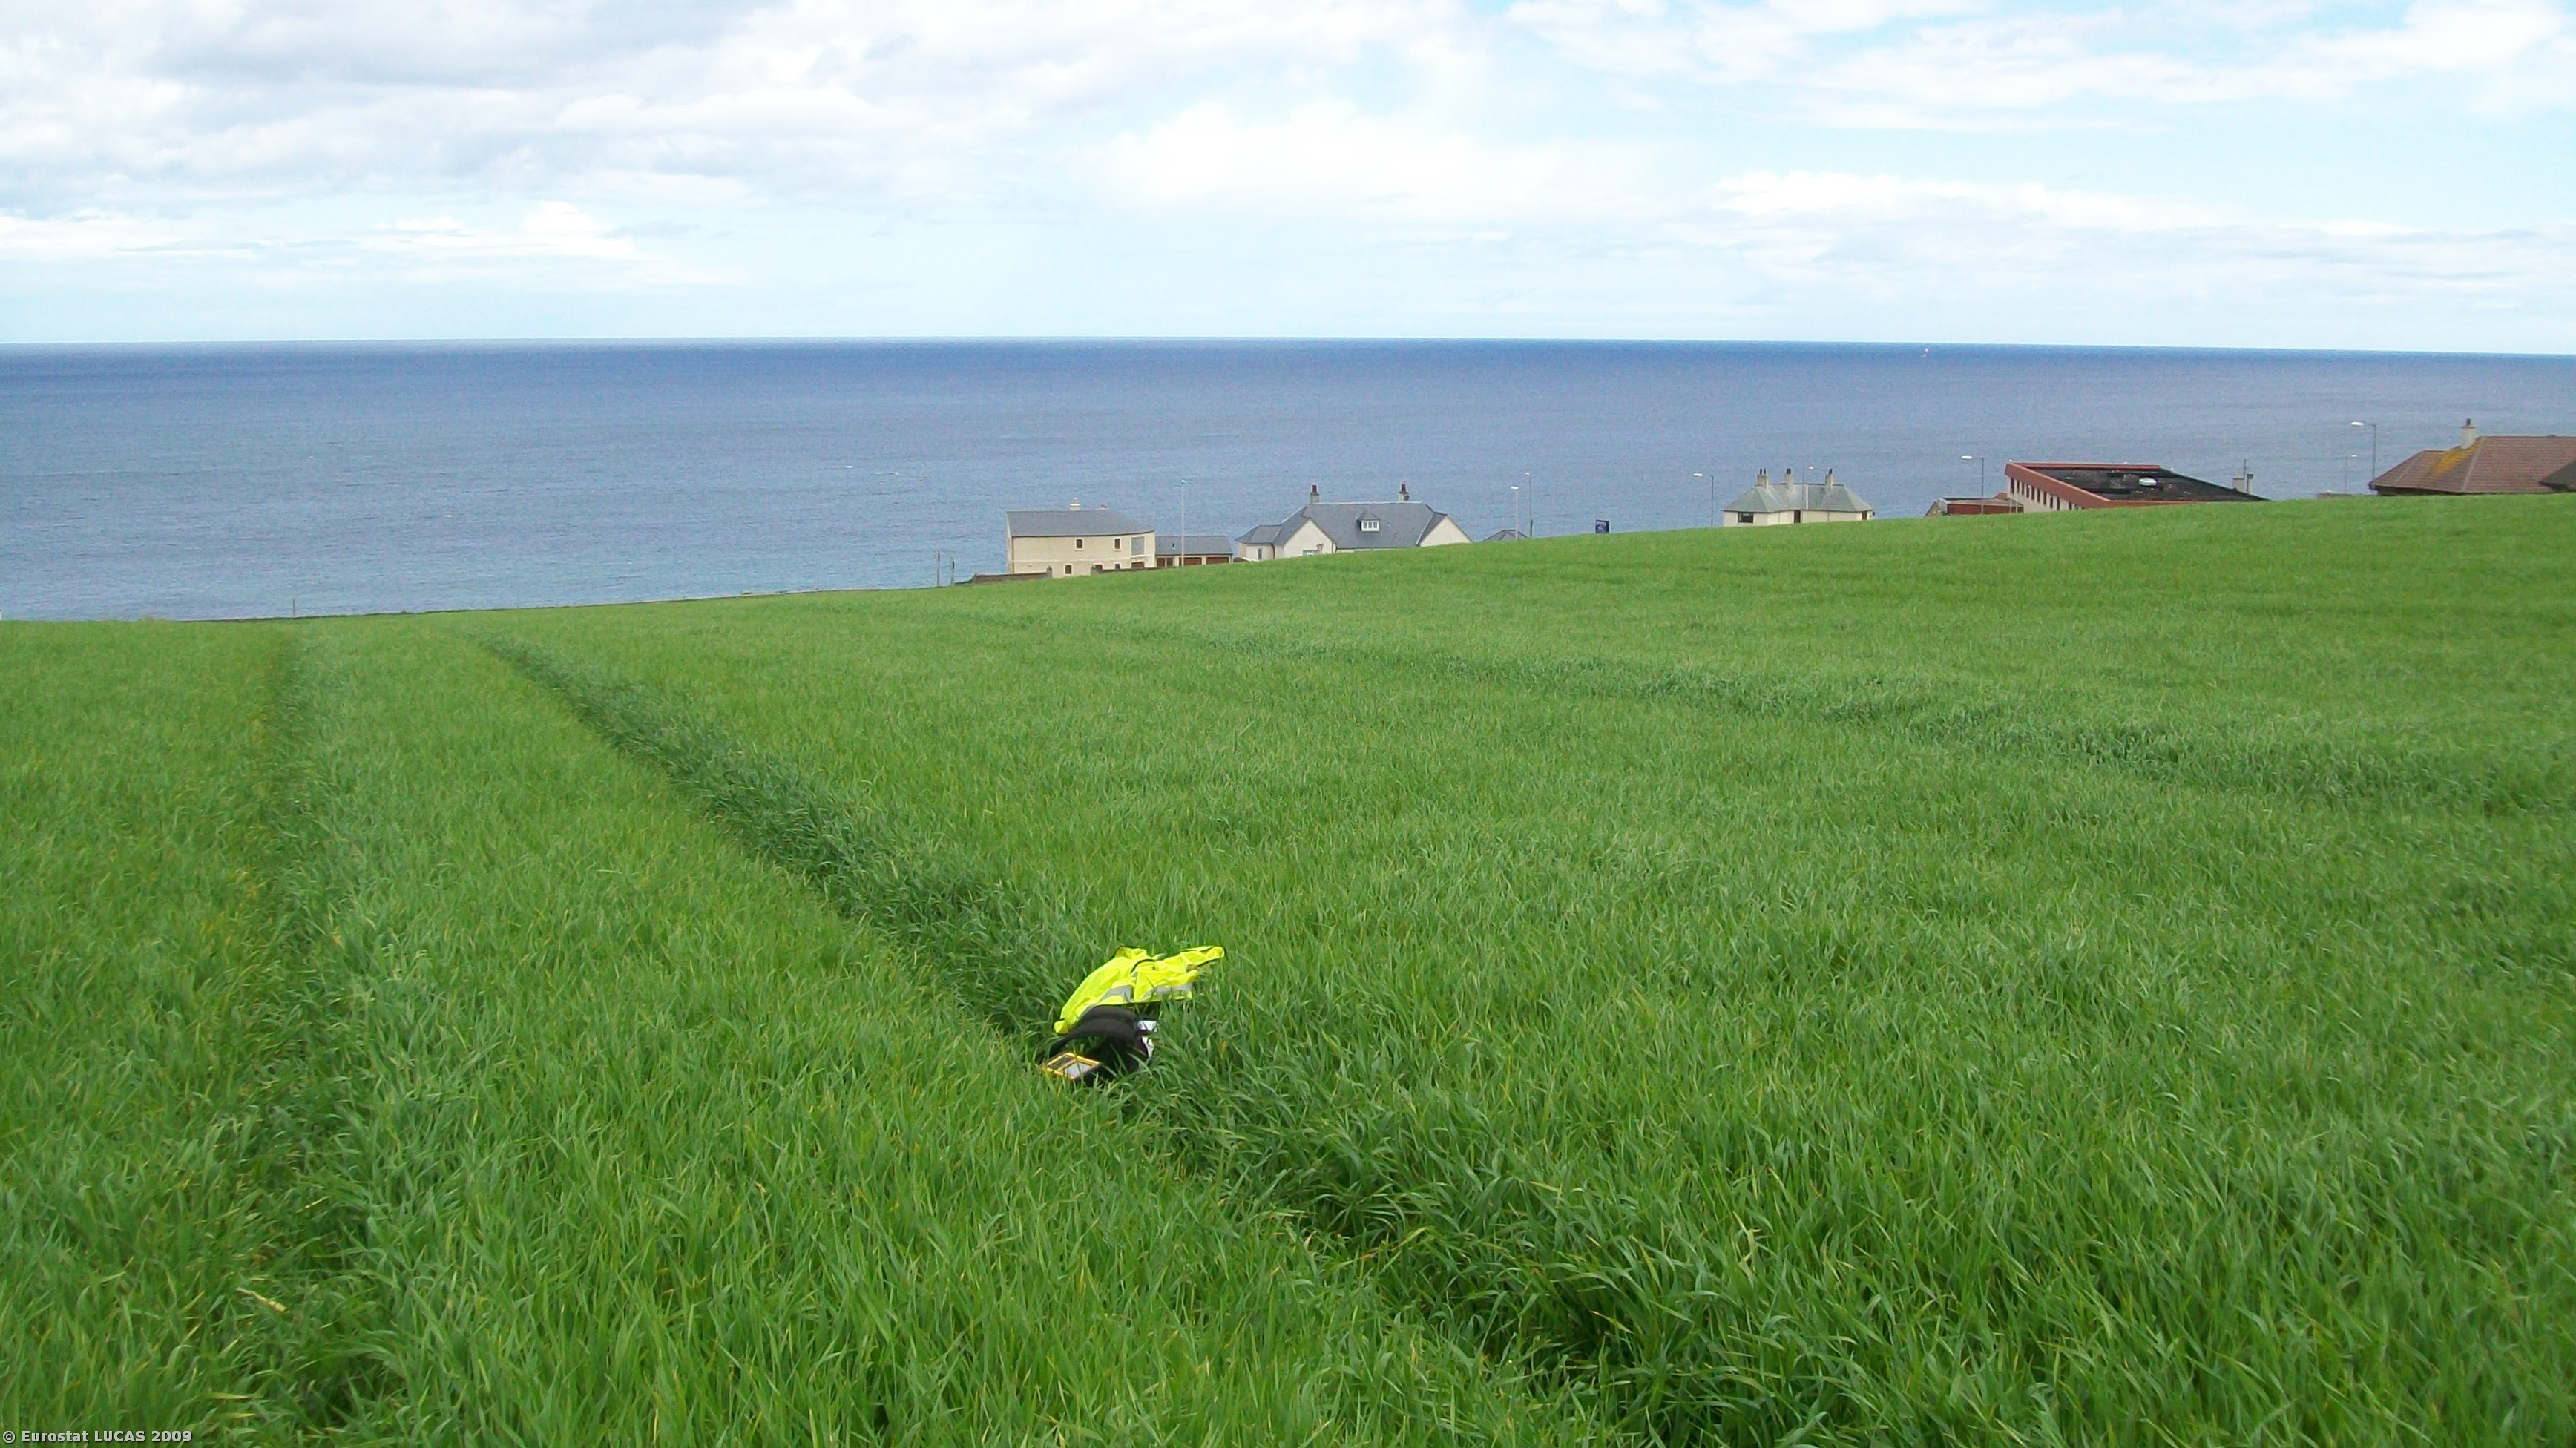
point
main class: Cropland
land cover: Oats
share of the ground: 50 - 75 %
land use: Agriculture (excluding fallow land and kitchen gardens)
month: June
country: GB
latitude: 57.6656
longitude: -2.5412
